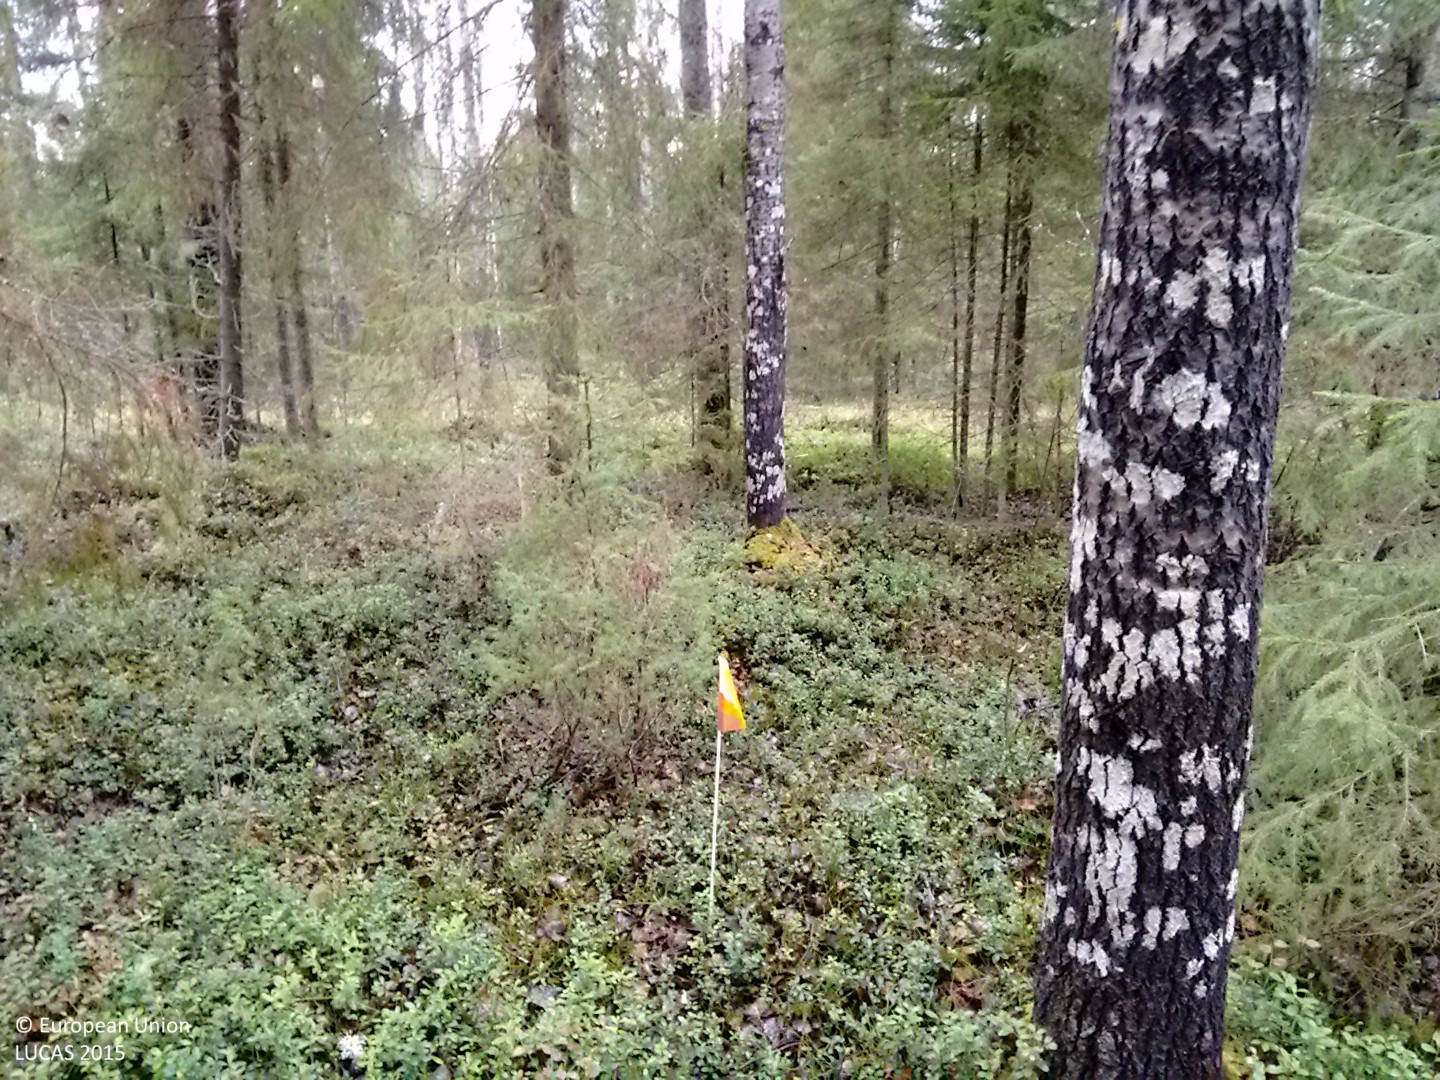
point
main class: Woodland
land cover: Spruce dominated mixed woodland
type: boreal forest
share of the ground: > 75 %
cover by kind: coniferous forest trees 60 %, broadleaved forest trees 25 %, shrubs 15 %
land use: Forestry
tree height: > 5 m
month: October
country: FI
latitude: 64.4722
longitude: 25.2034
